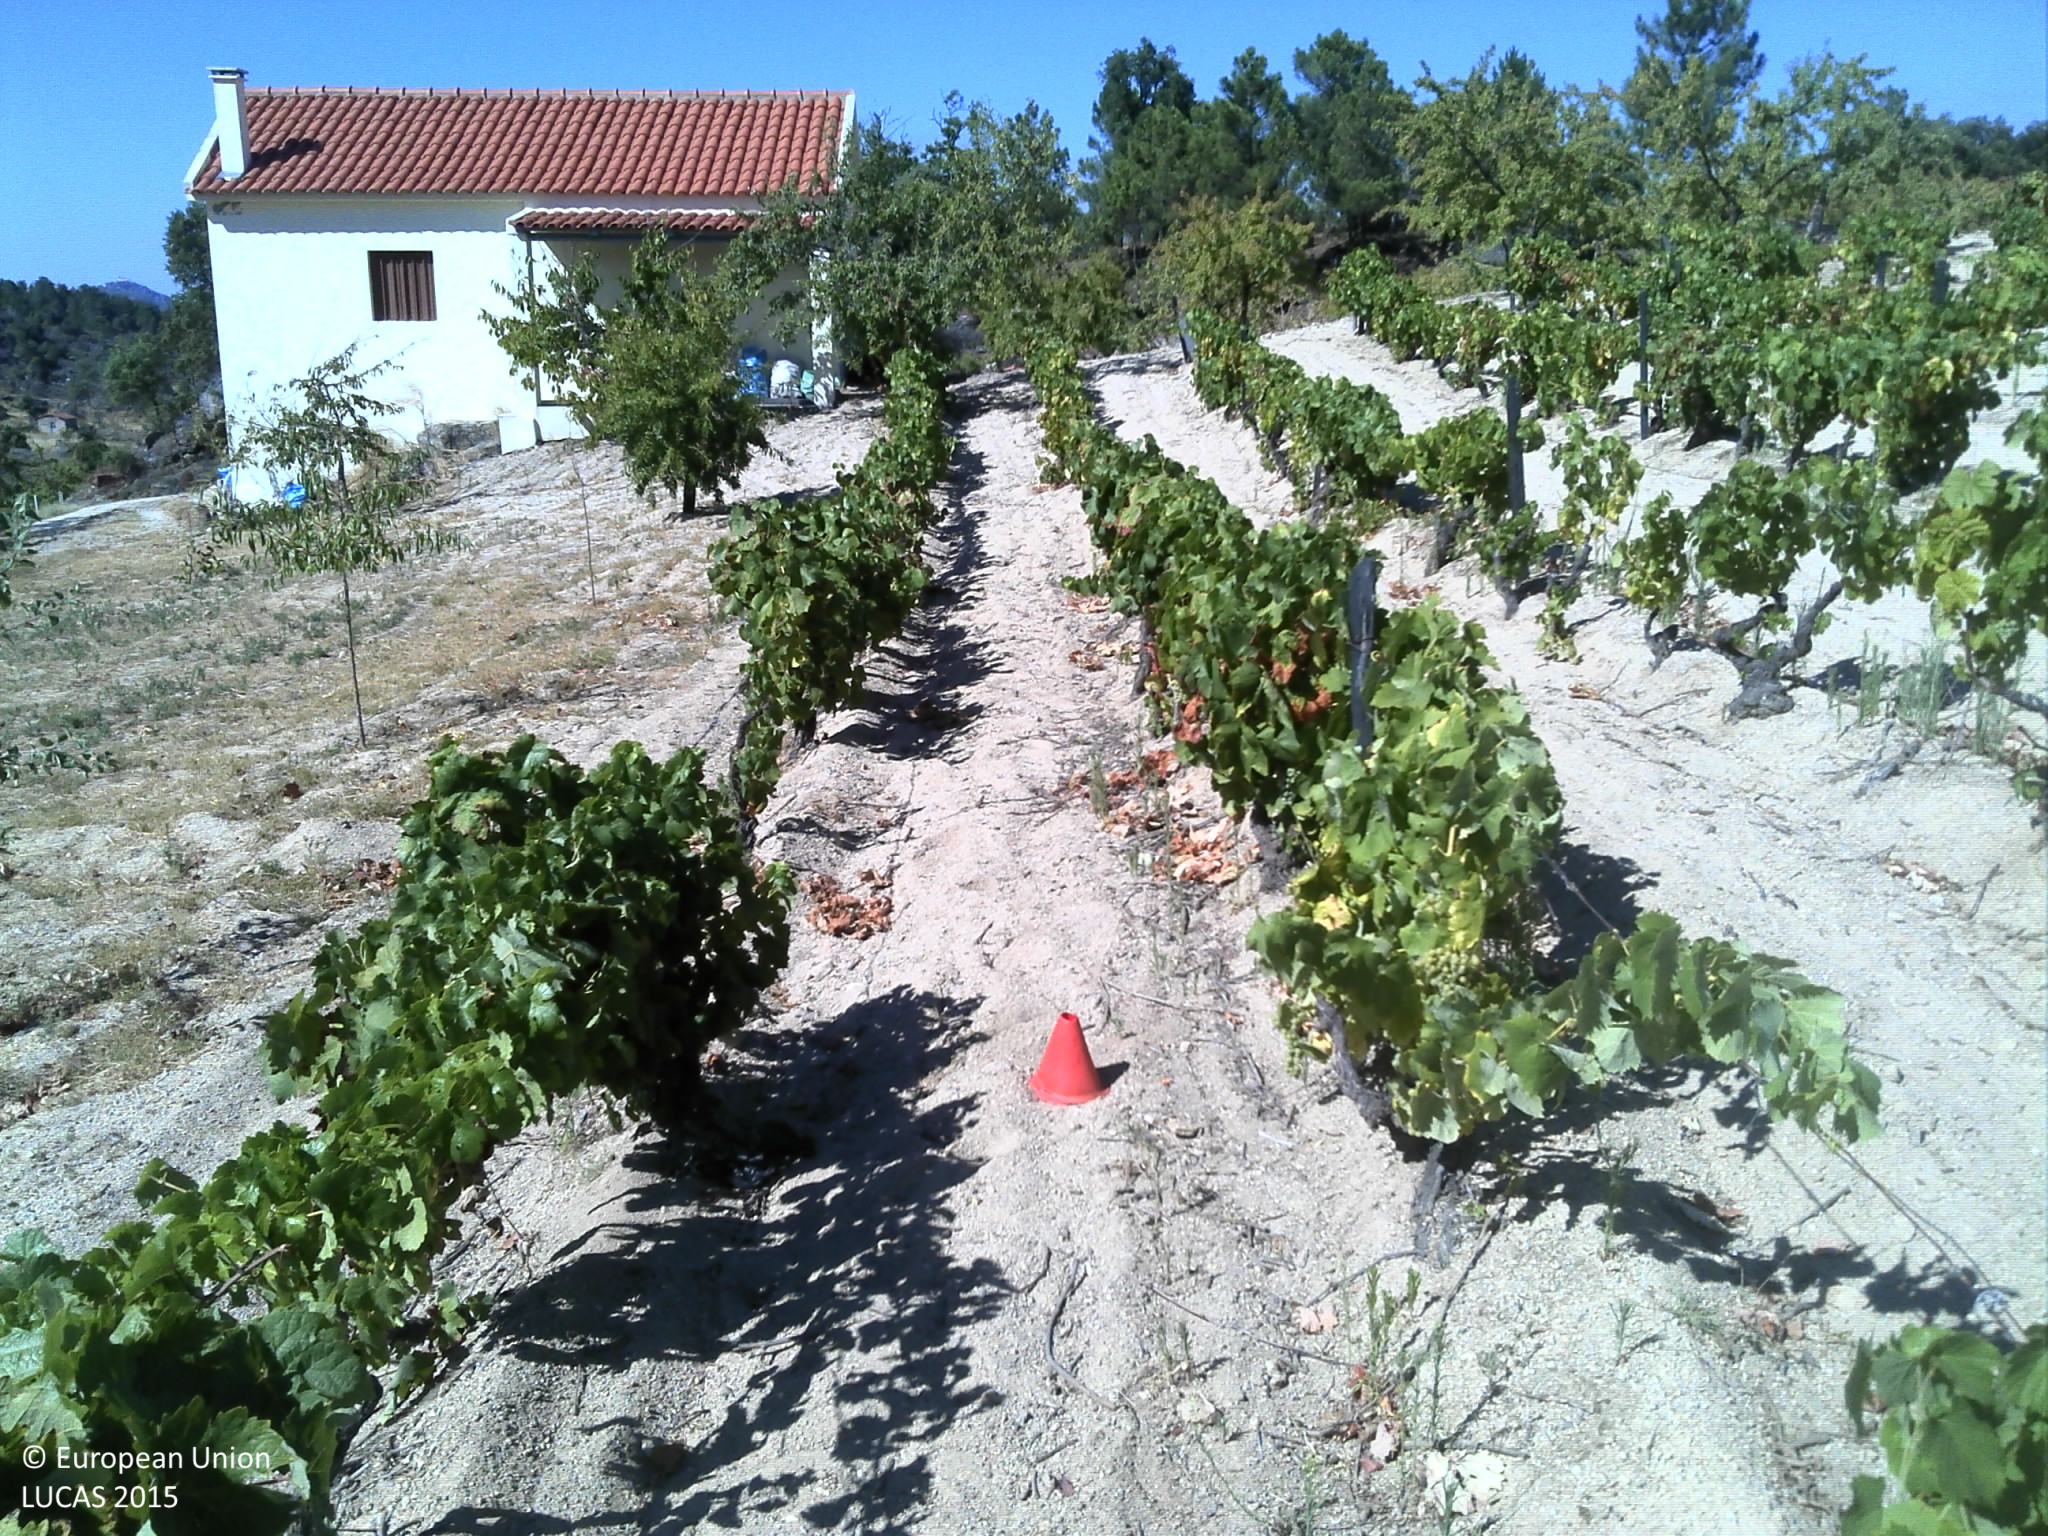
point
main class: Cropland
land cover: Vineyards
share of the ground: 10 - 25 %
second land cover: Other bare soil
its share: > 75 %
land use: Agriculture (excluding fallow land and kitchen gardens)
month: July
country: PT
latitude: 41.2841
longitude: -7.1777
